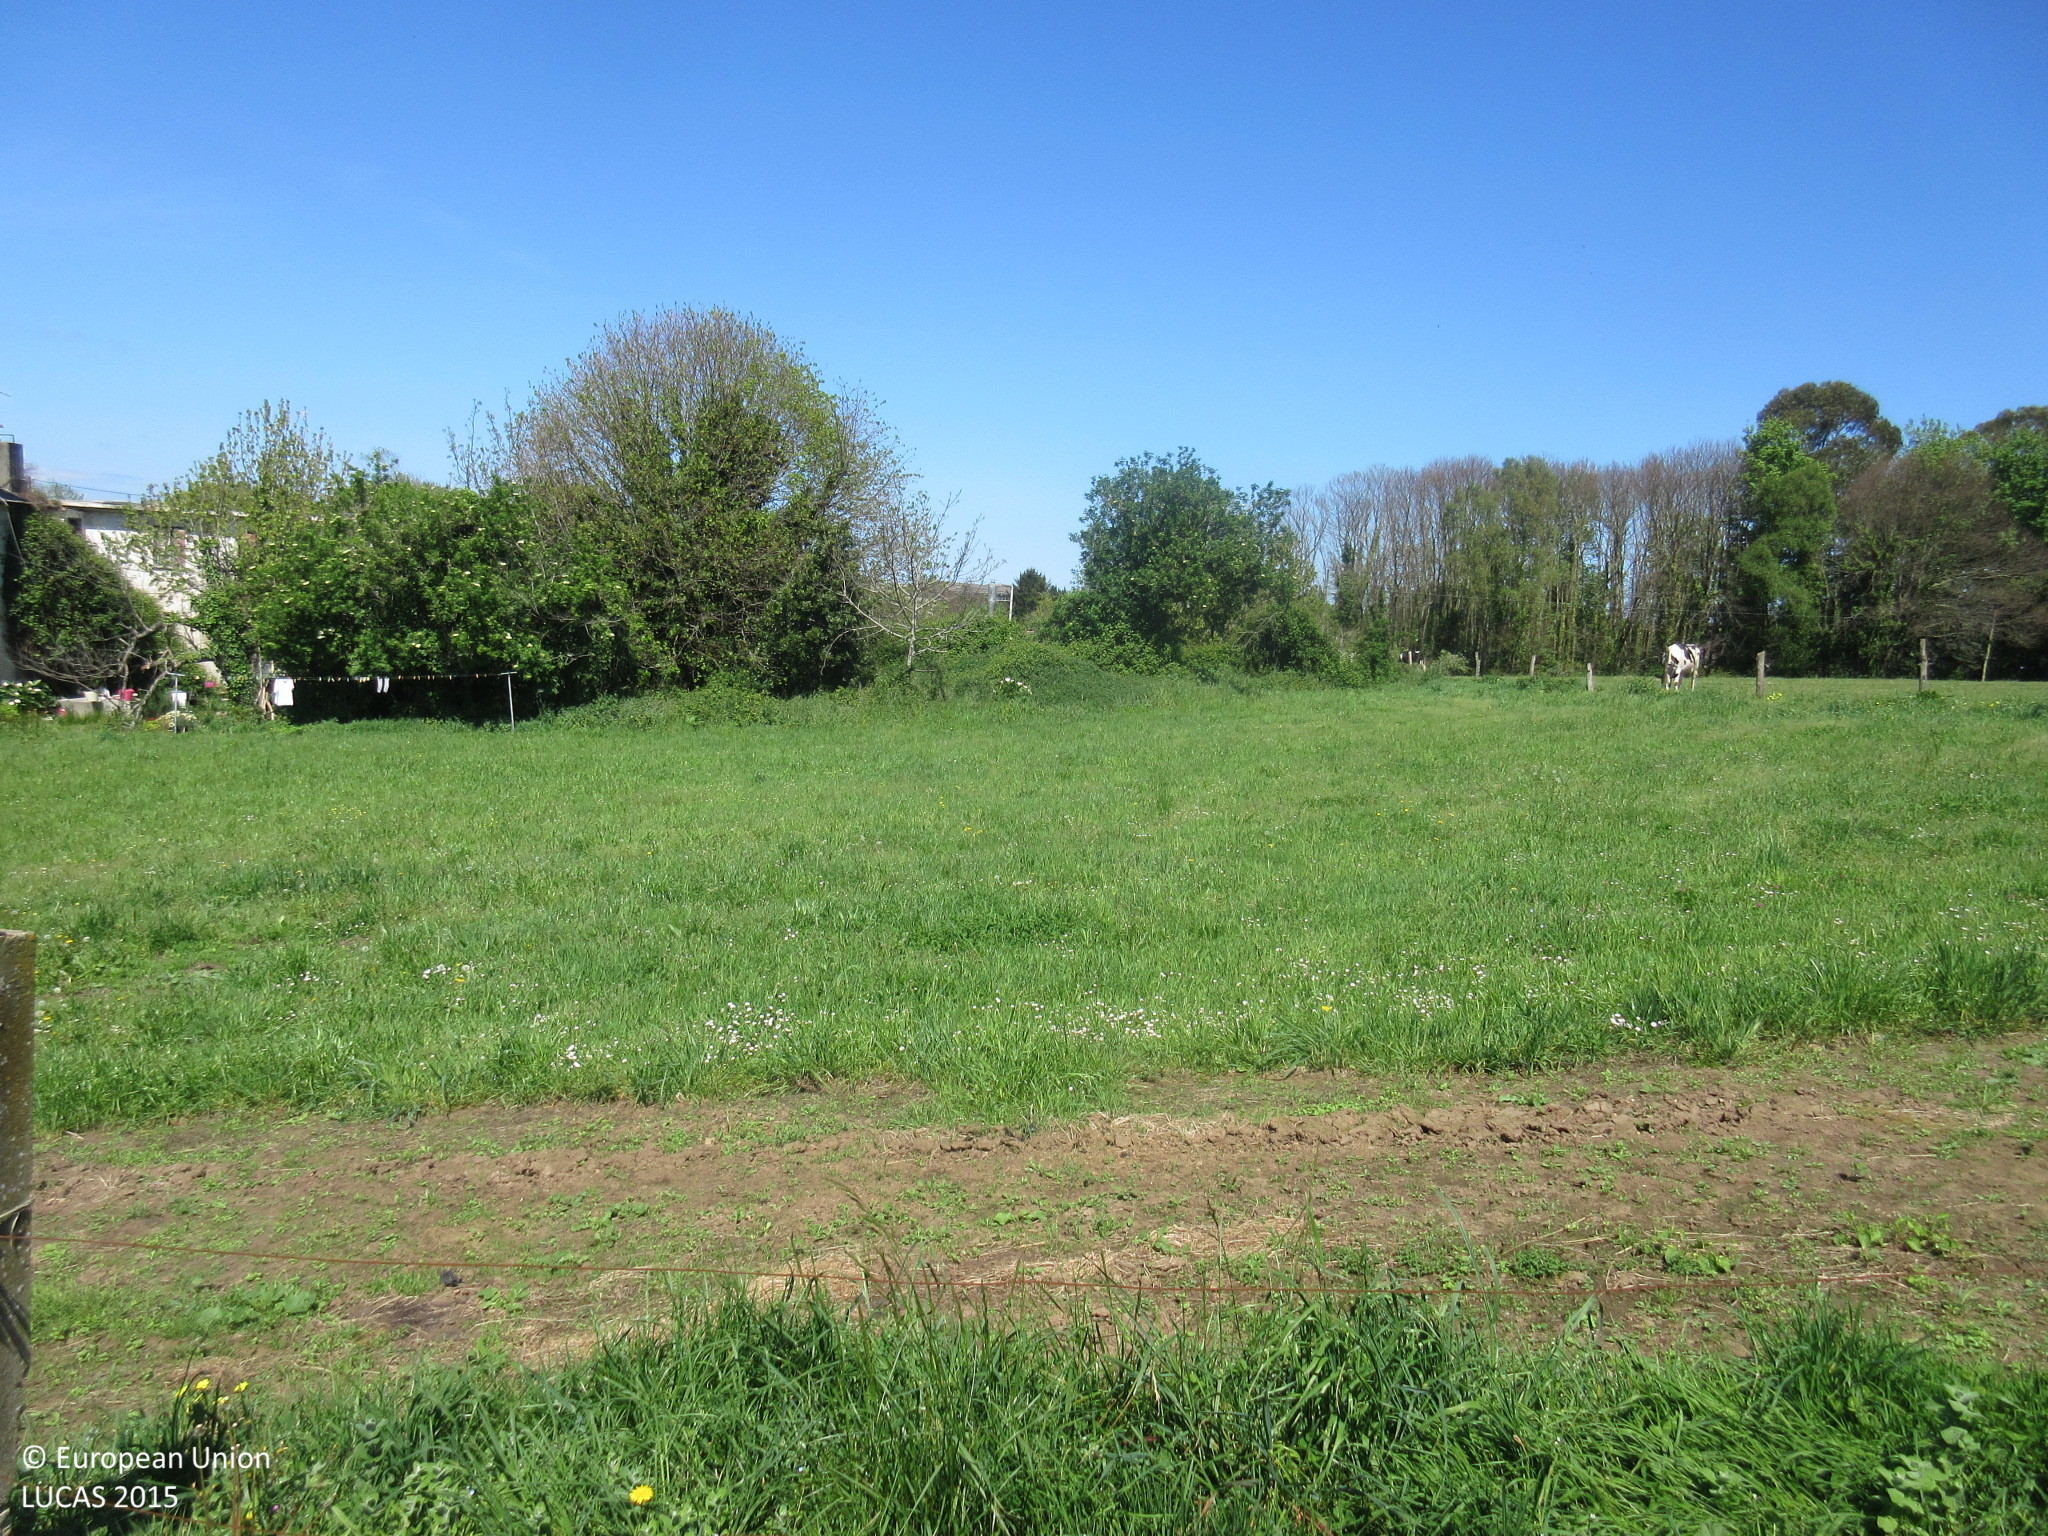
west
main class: Grassland
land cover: Grassland without tree/shrub cover
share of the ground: > 75 %
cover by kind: herbaceous plants 100 %
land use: Agriculture (excluding fallow land and kitchen gardens)
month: April
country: ES
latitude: 43.5191
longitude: -7.0301
